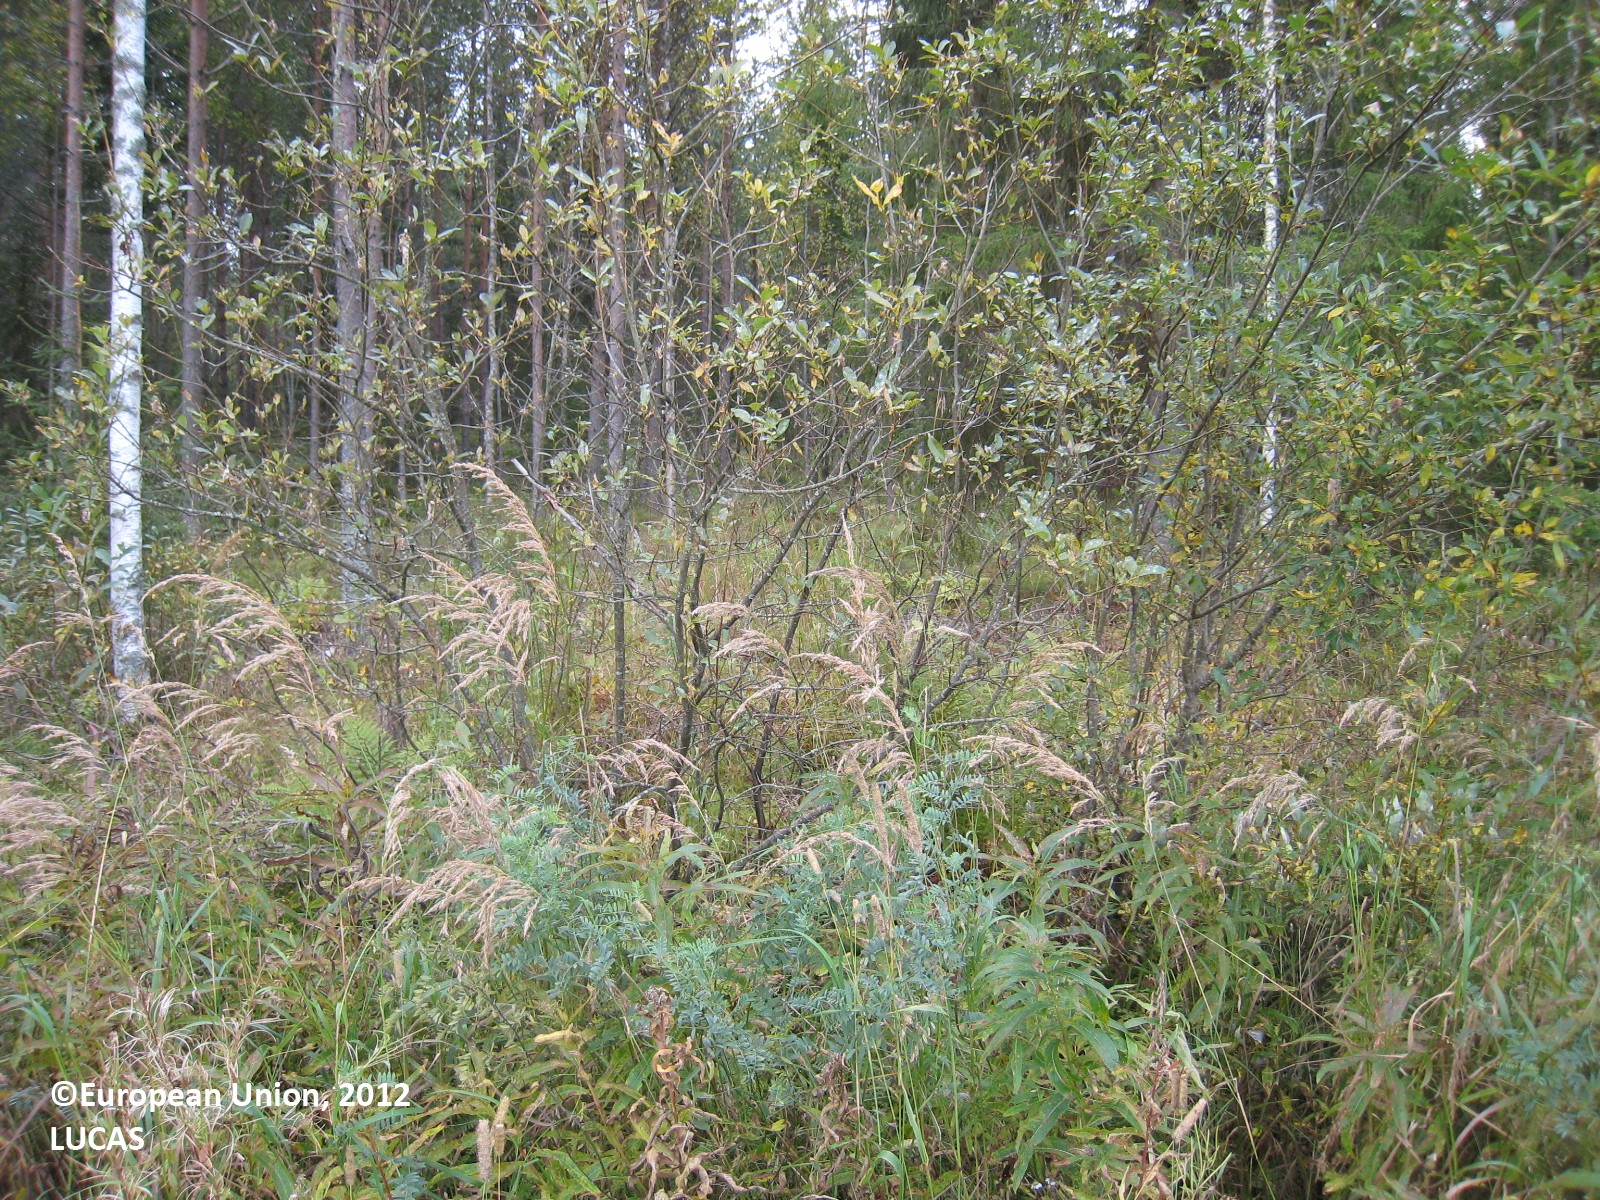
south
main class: Cropland
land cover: Temporary grasslands
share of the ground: > 75 %
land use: Agriculture (excluding fallow land and kitchen gardens)
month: September
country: FI
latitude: 63.2320
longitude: 26.4681
